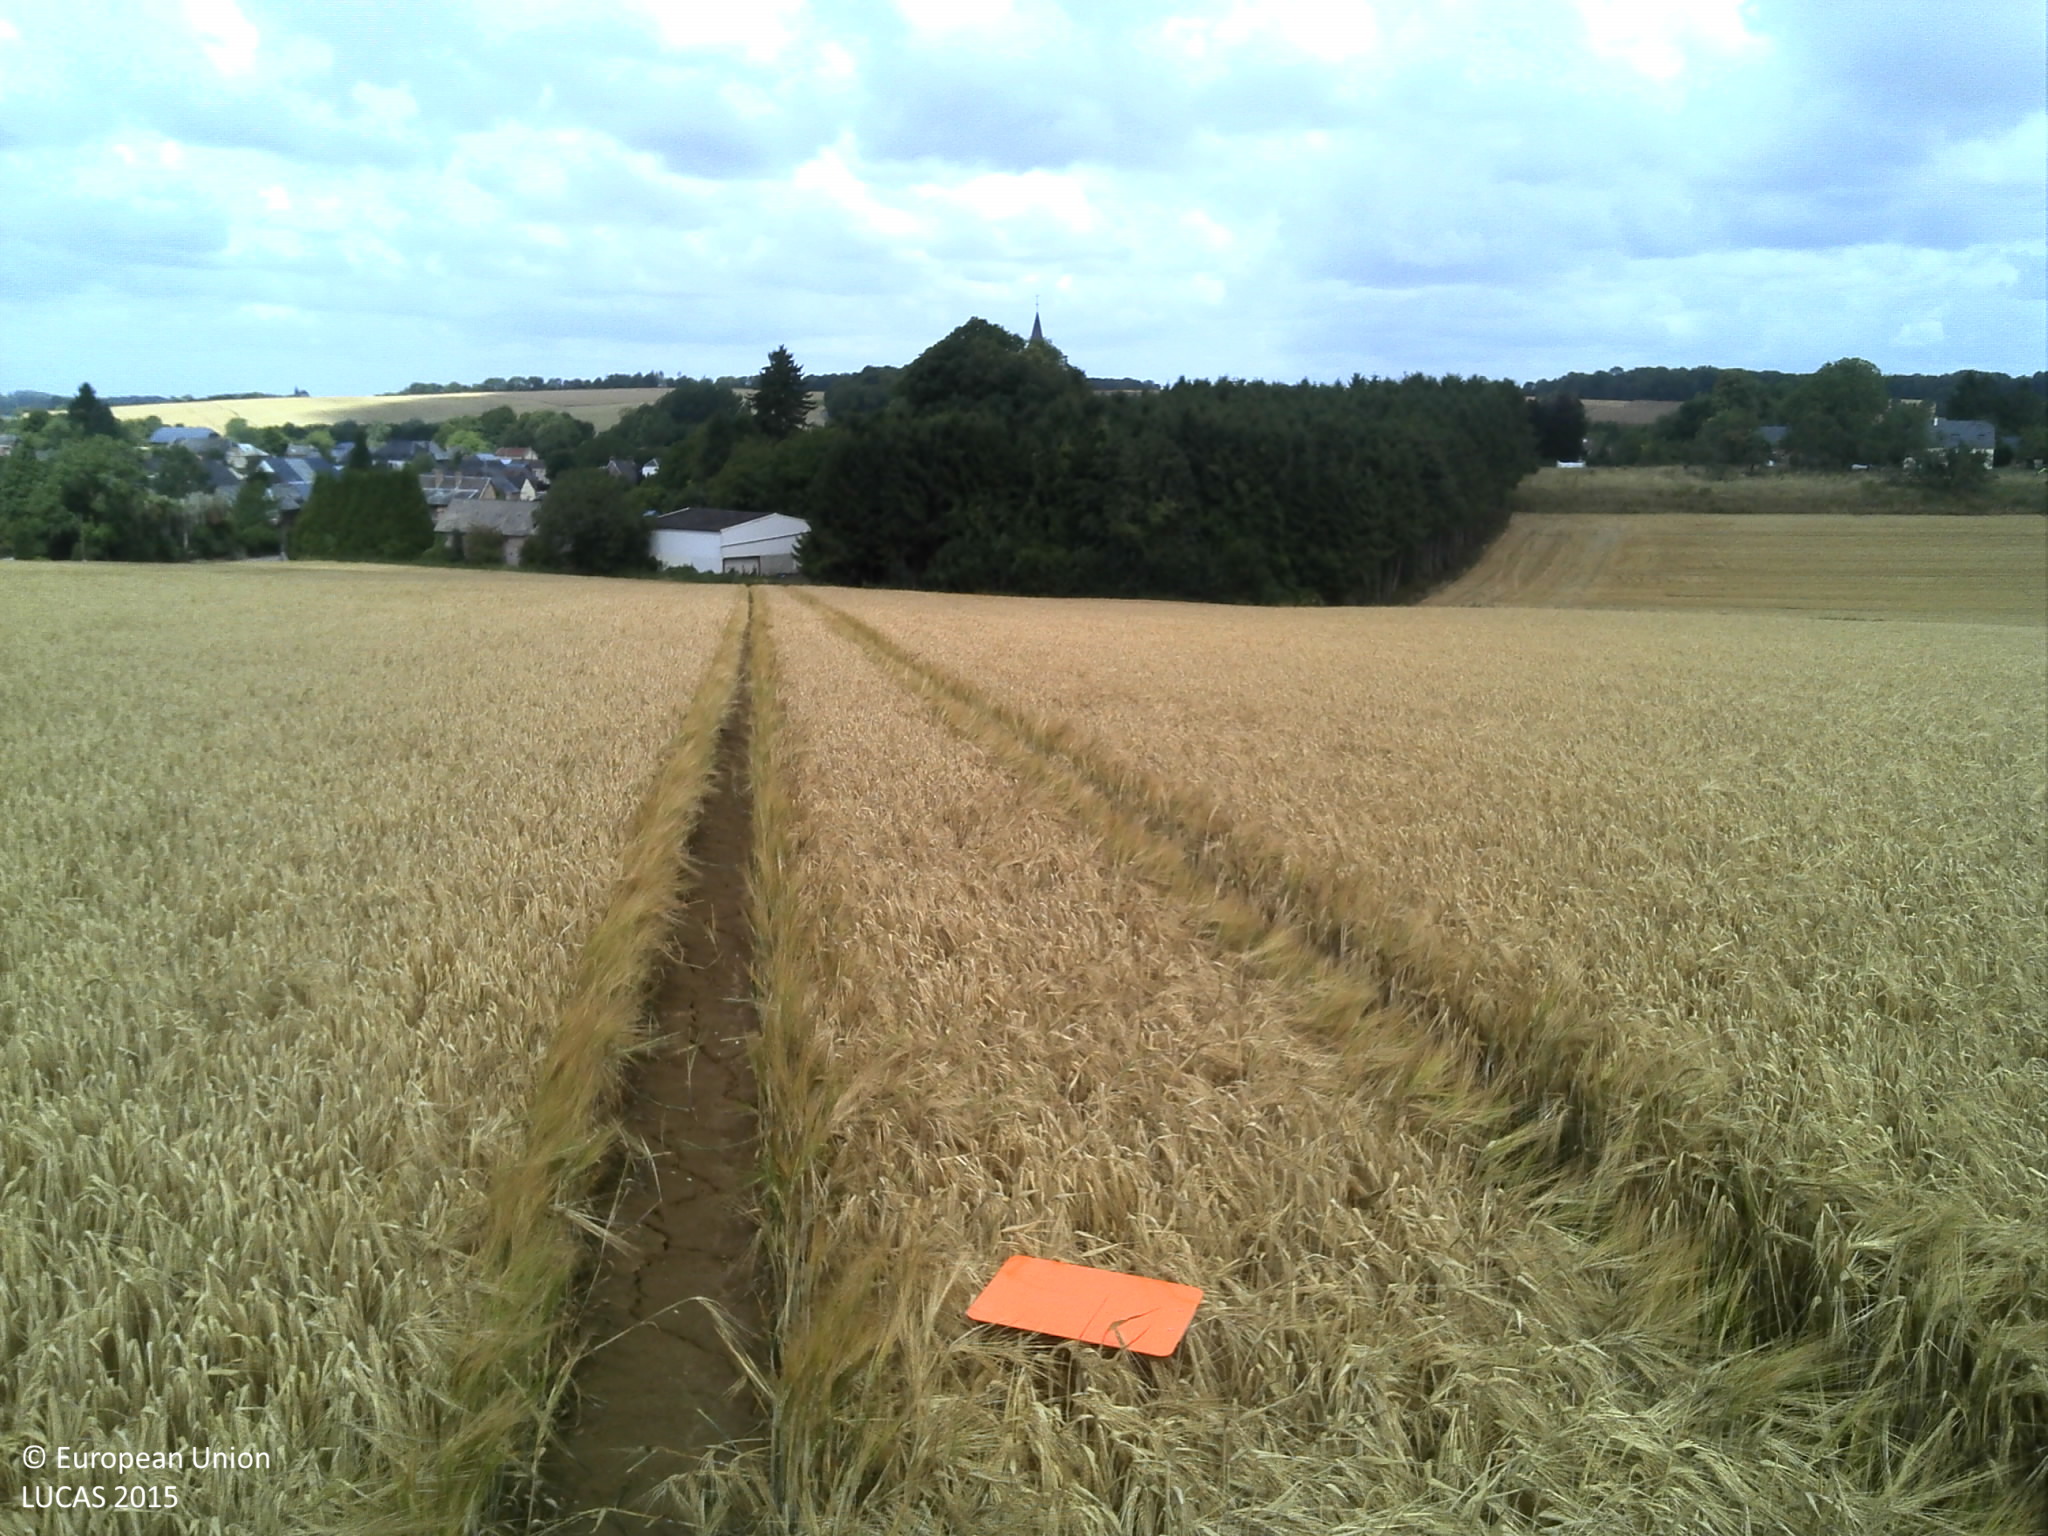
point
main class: Cropland
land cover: Barley
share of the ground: > 75 %
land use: Agriculture (excluding fallow land and kitchen gardens)
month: July
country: FR
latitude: 49.6547
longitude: 4.1357
